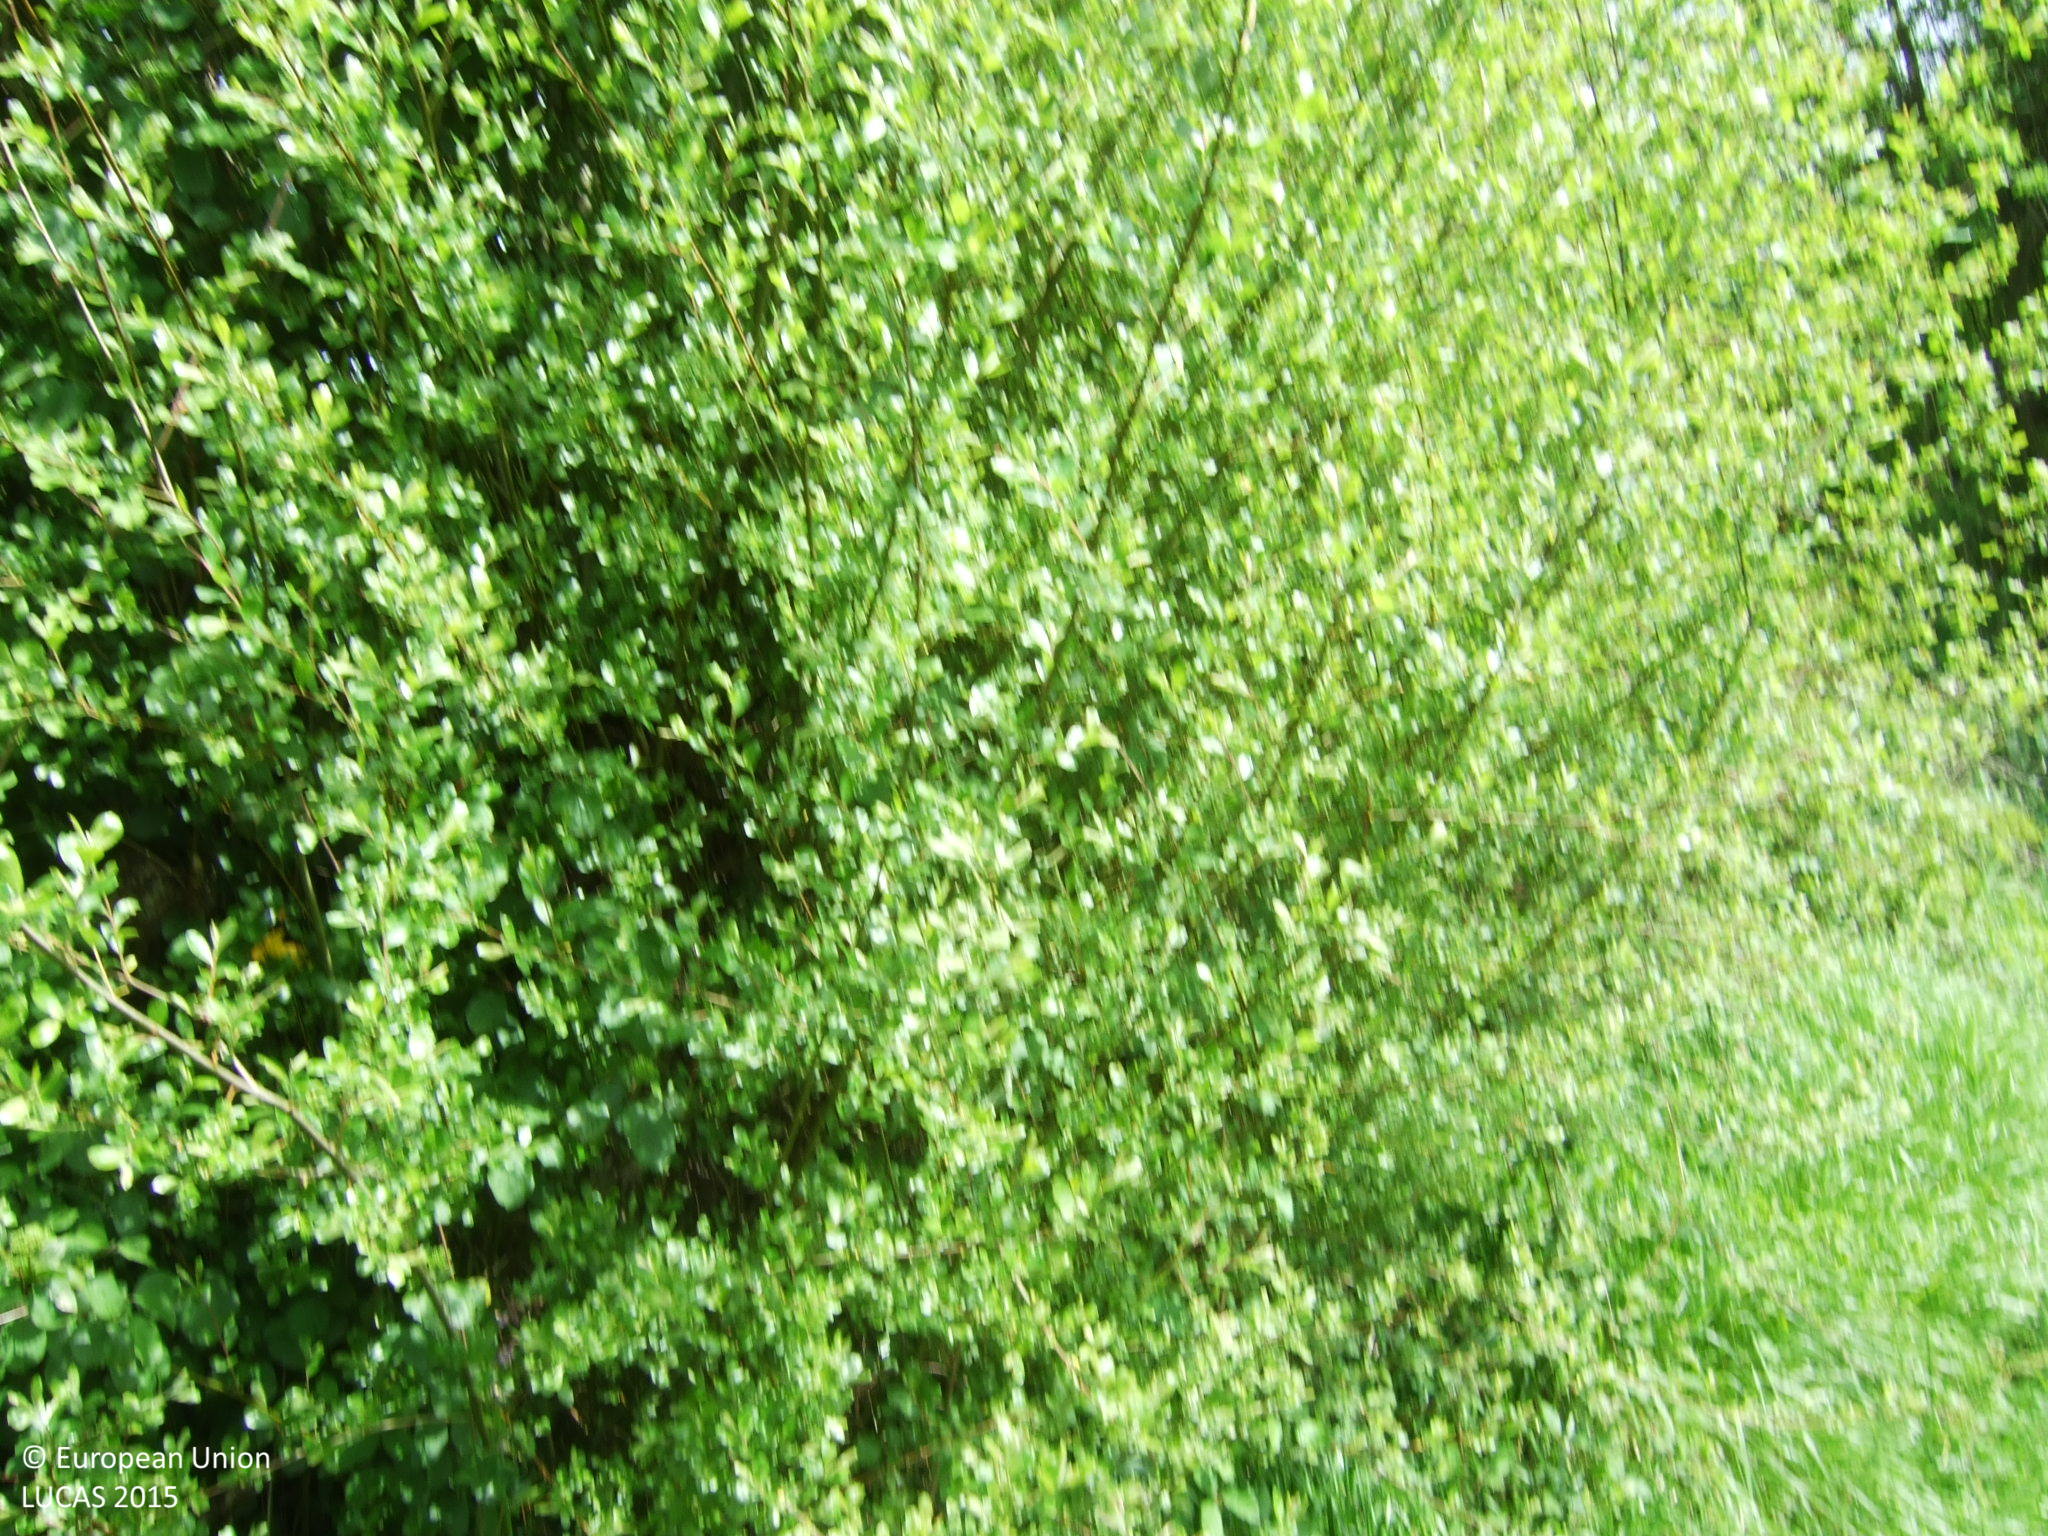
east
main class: Grassland
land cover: Grassland without tree/shrub cover
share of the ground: > 75 %
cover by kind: herbaceous plants 100 %
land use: Agriculture (excluding fallow land and kitchen gardens)
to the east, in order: Grassland without tree/shrub cover; Broadleaved woodland; Tracks; Shruby margins; Grassland without tree/shrub cover; Shrubland with sparse tree cover; Fences; Grassland without tree/shrub cover; Fences; Shruby margins; Tracks
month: May
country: ES
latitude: 42.8372
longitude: -7.3569
